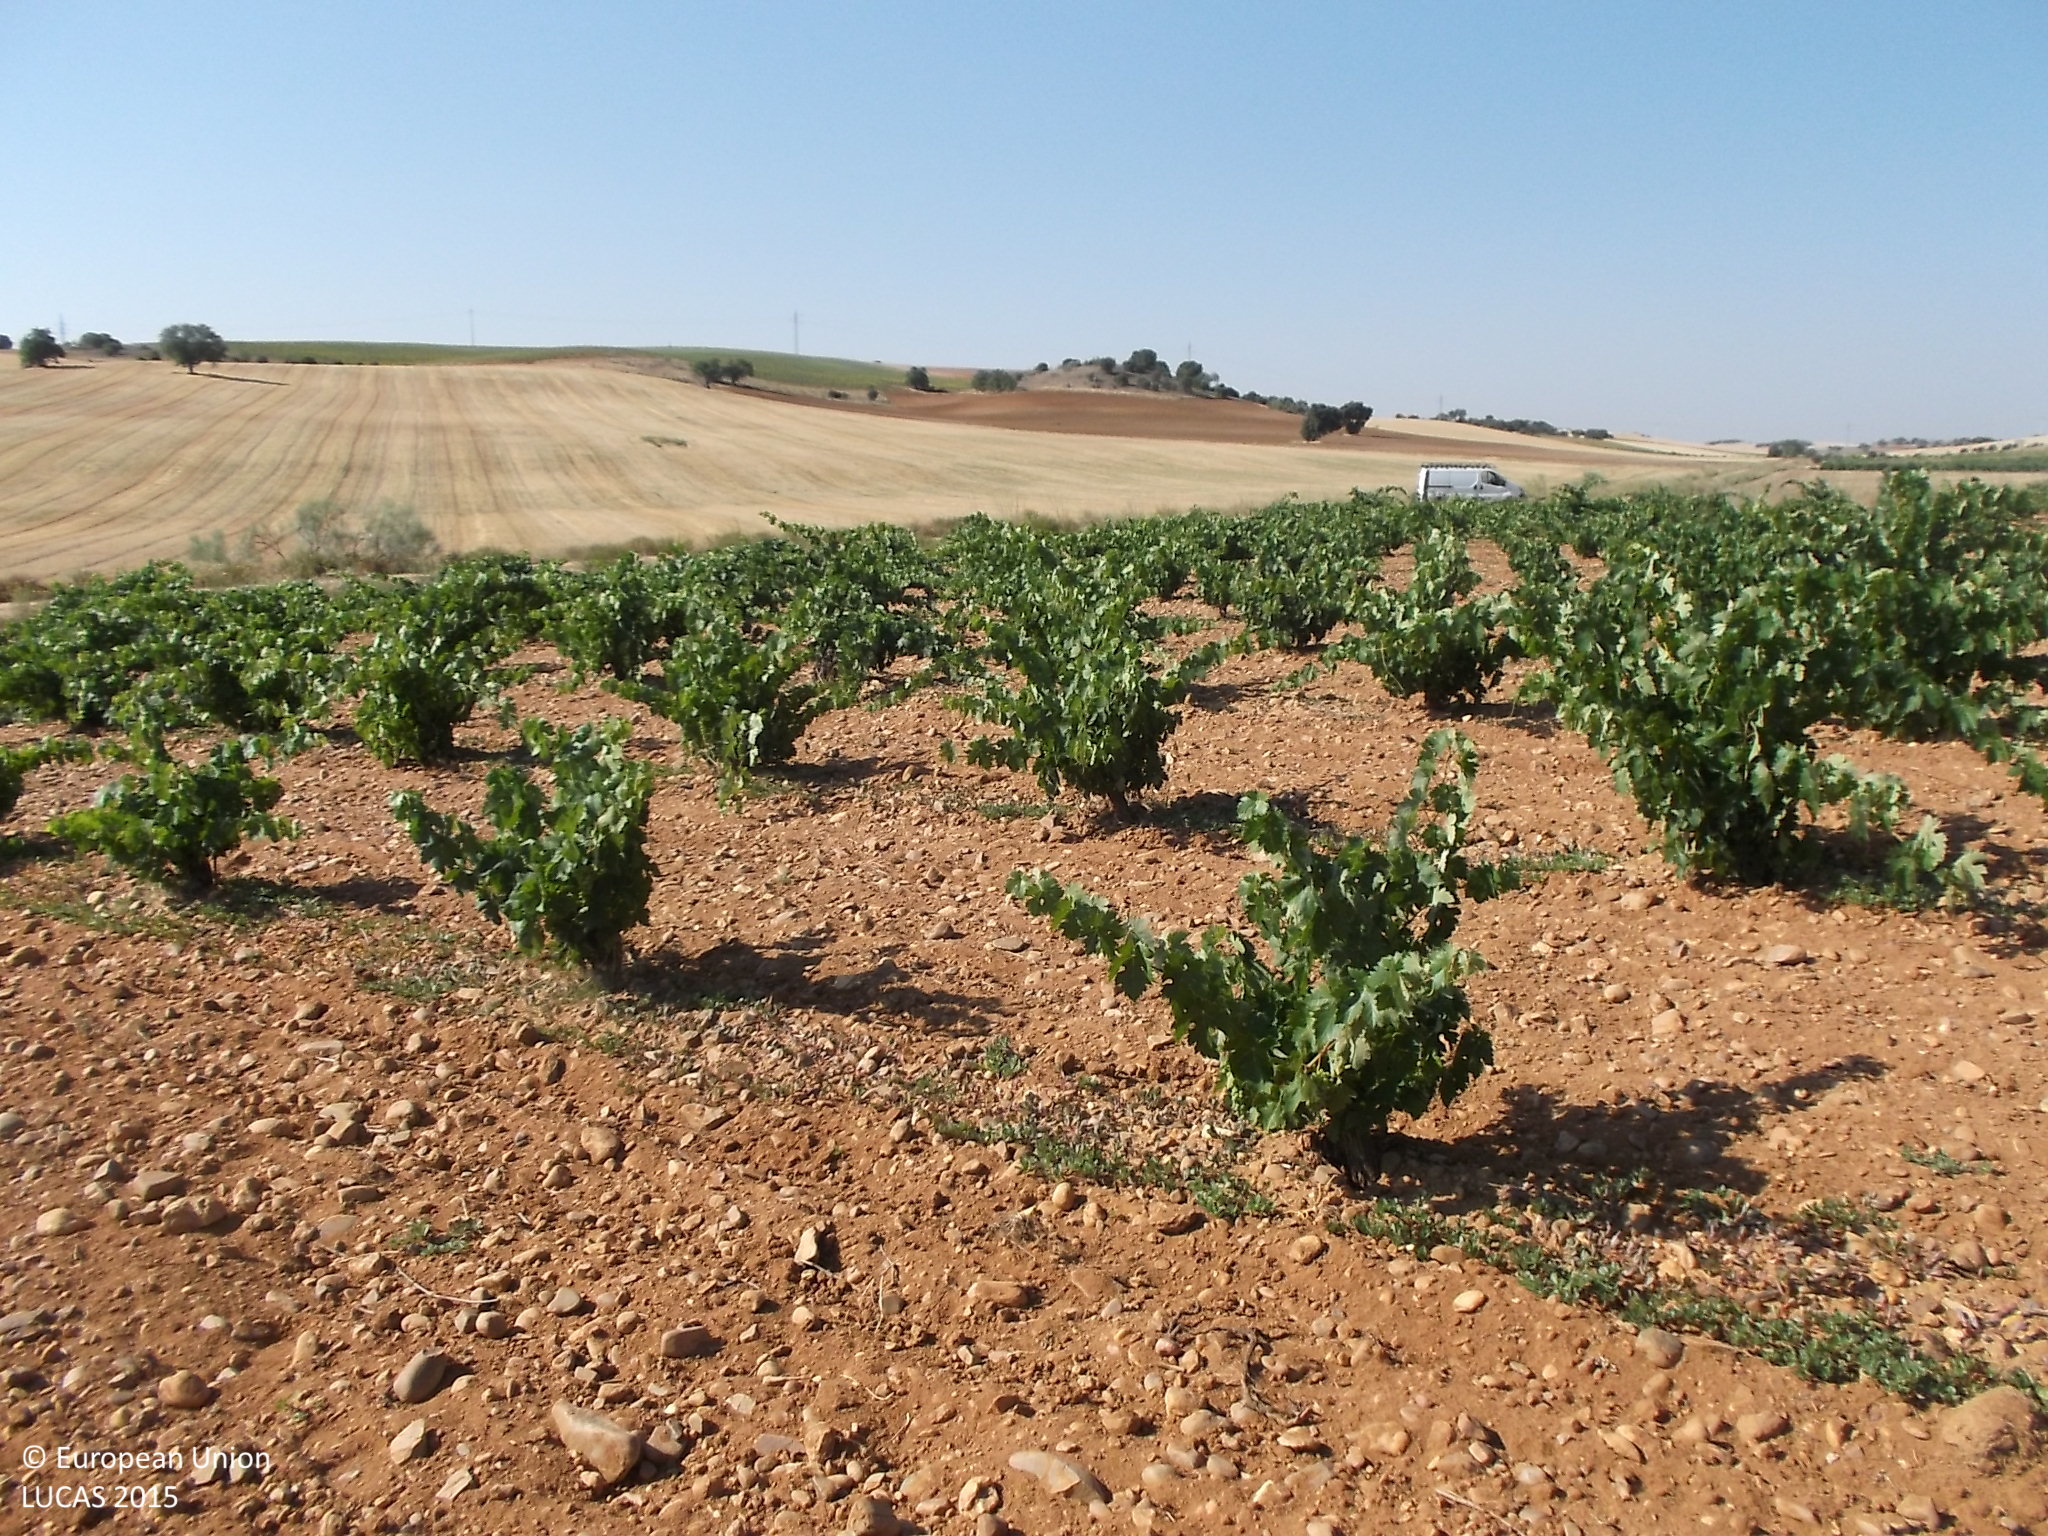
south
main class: Cropland
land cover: Vineyards
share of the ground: 10 - 25 %
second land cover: Other bare soil
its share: > 75 %
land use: Agriculture (excluding fallow land and kitchen gardens)
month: July
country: ES
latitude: 41.4338
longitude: -5.3845
